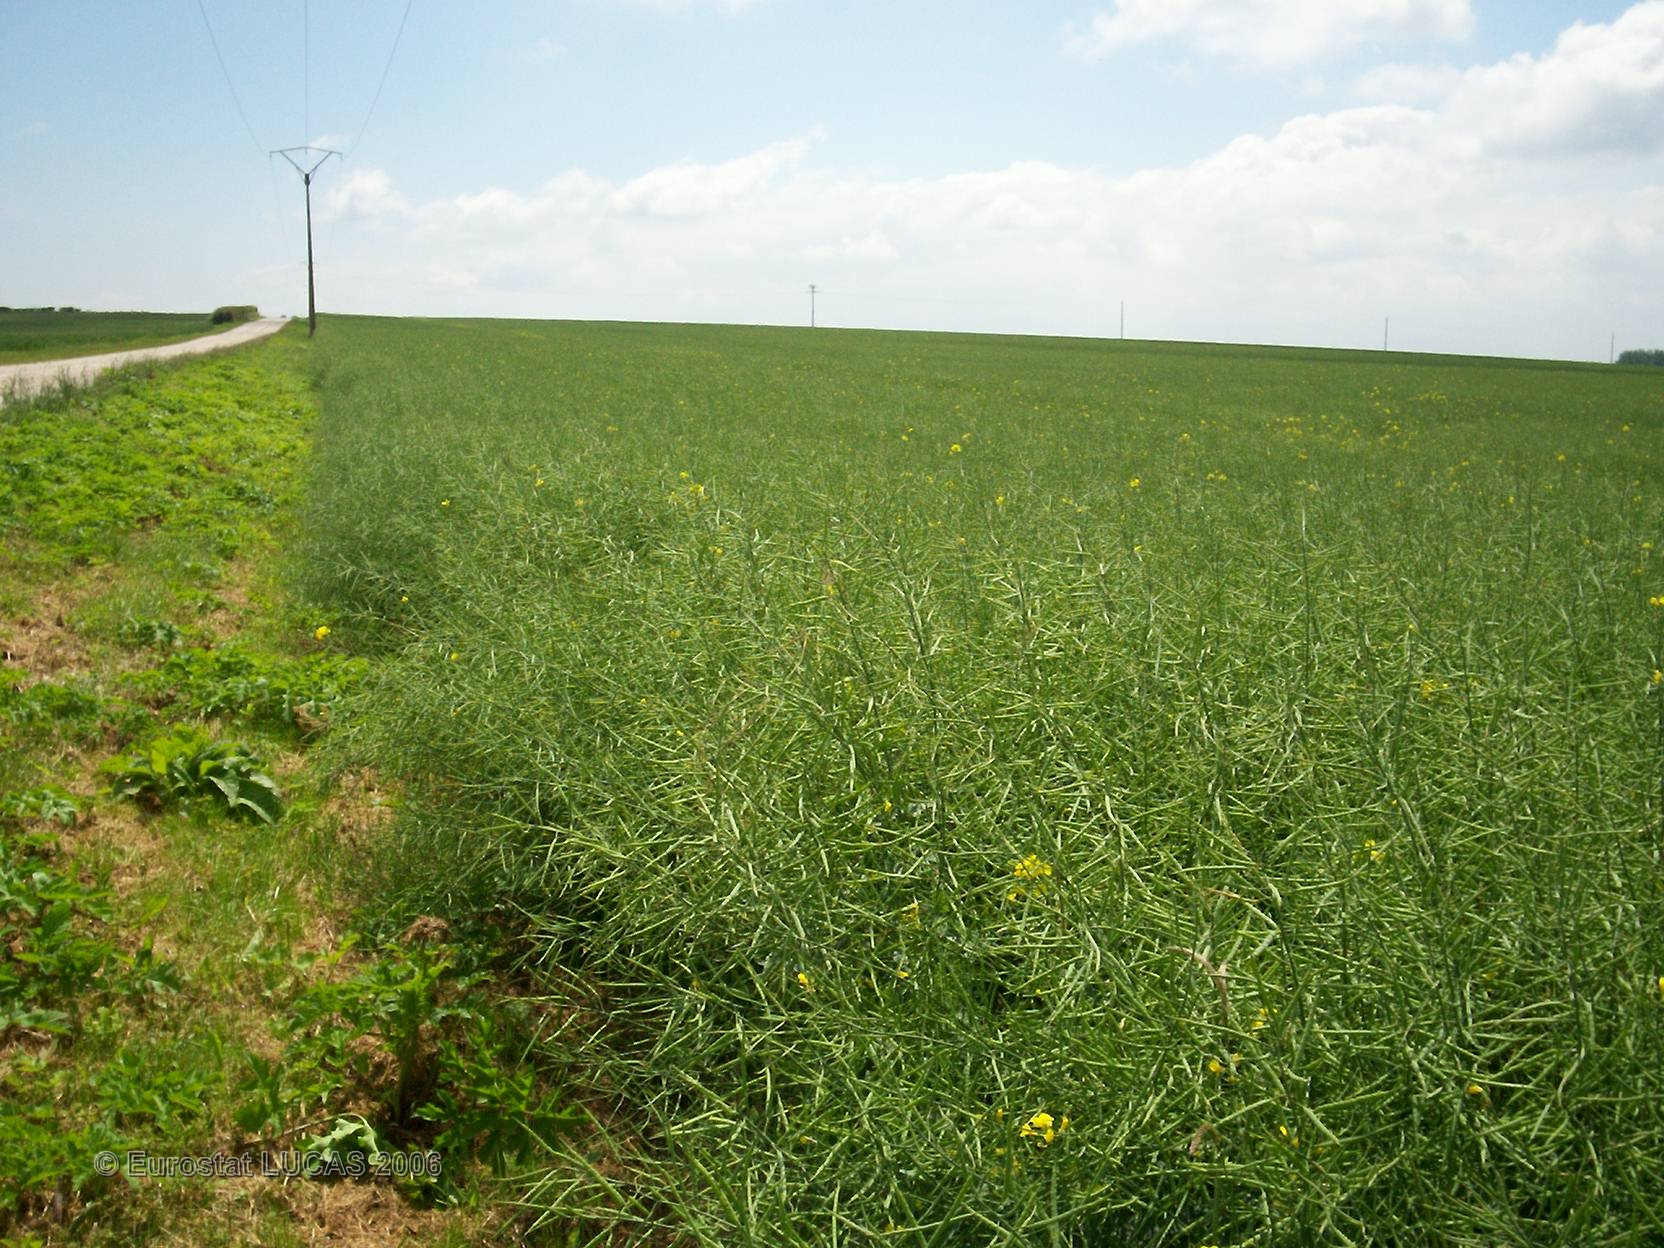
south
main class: Cropland
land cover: Rape and turnip rape
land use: Agriculture (excluding fallow land and kitchen gardens)
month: June
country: FR
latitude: 48.6234
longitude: 4.4210
